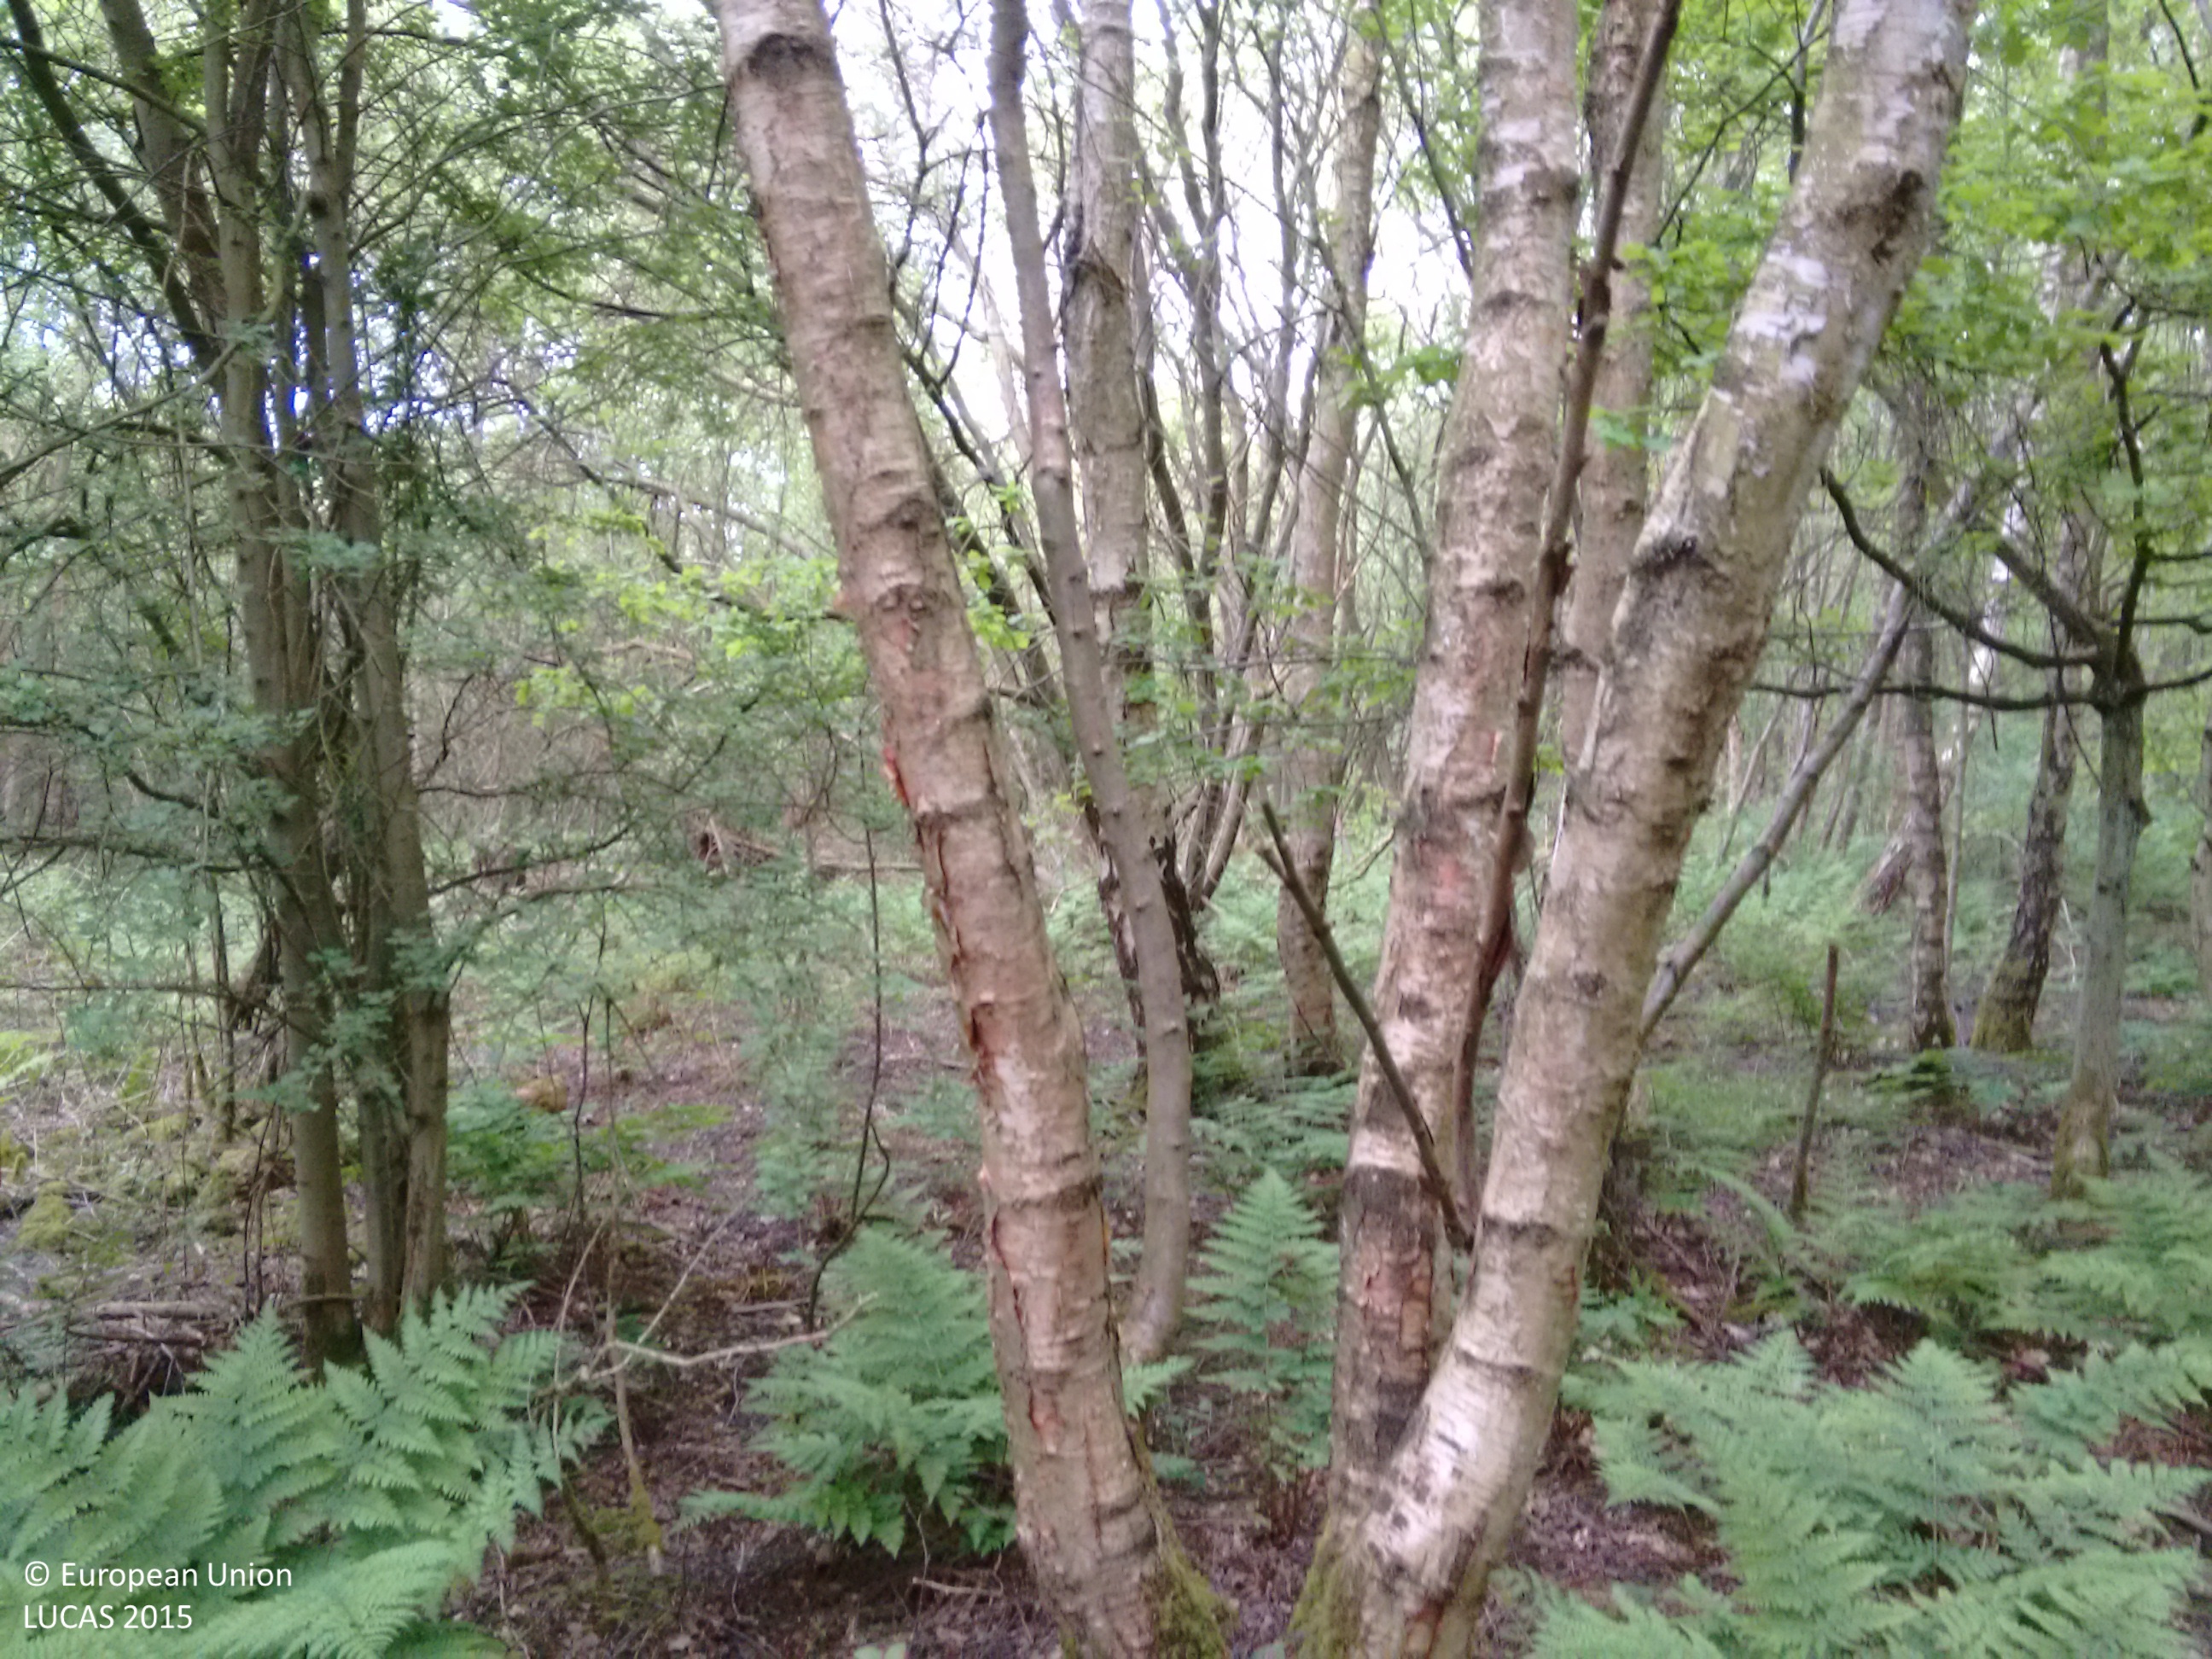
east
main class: Woodland
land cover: Broadleaved woodland
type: acidophilous oak and oak-birch forest
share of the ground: > 75 %
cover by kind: broadleaved forest trees 100 %
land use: Forestry
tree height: > 5 m
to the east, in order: Broadleaved woodland; Ditches and canals; Grass margins
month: May
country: GB
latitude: 53.4823
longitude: -0.3580
